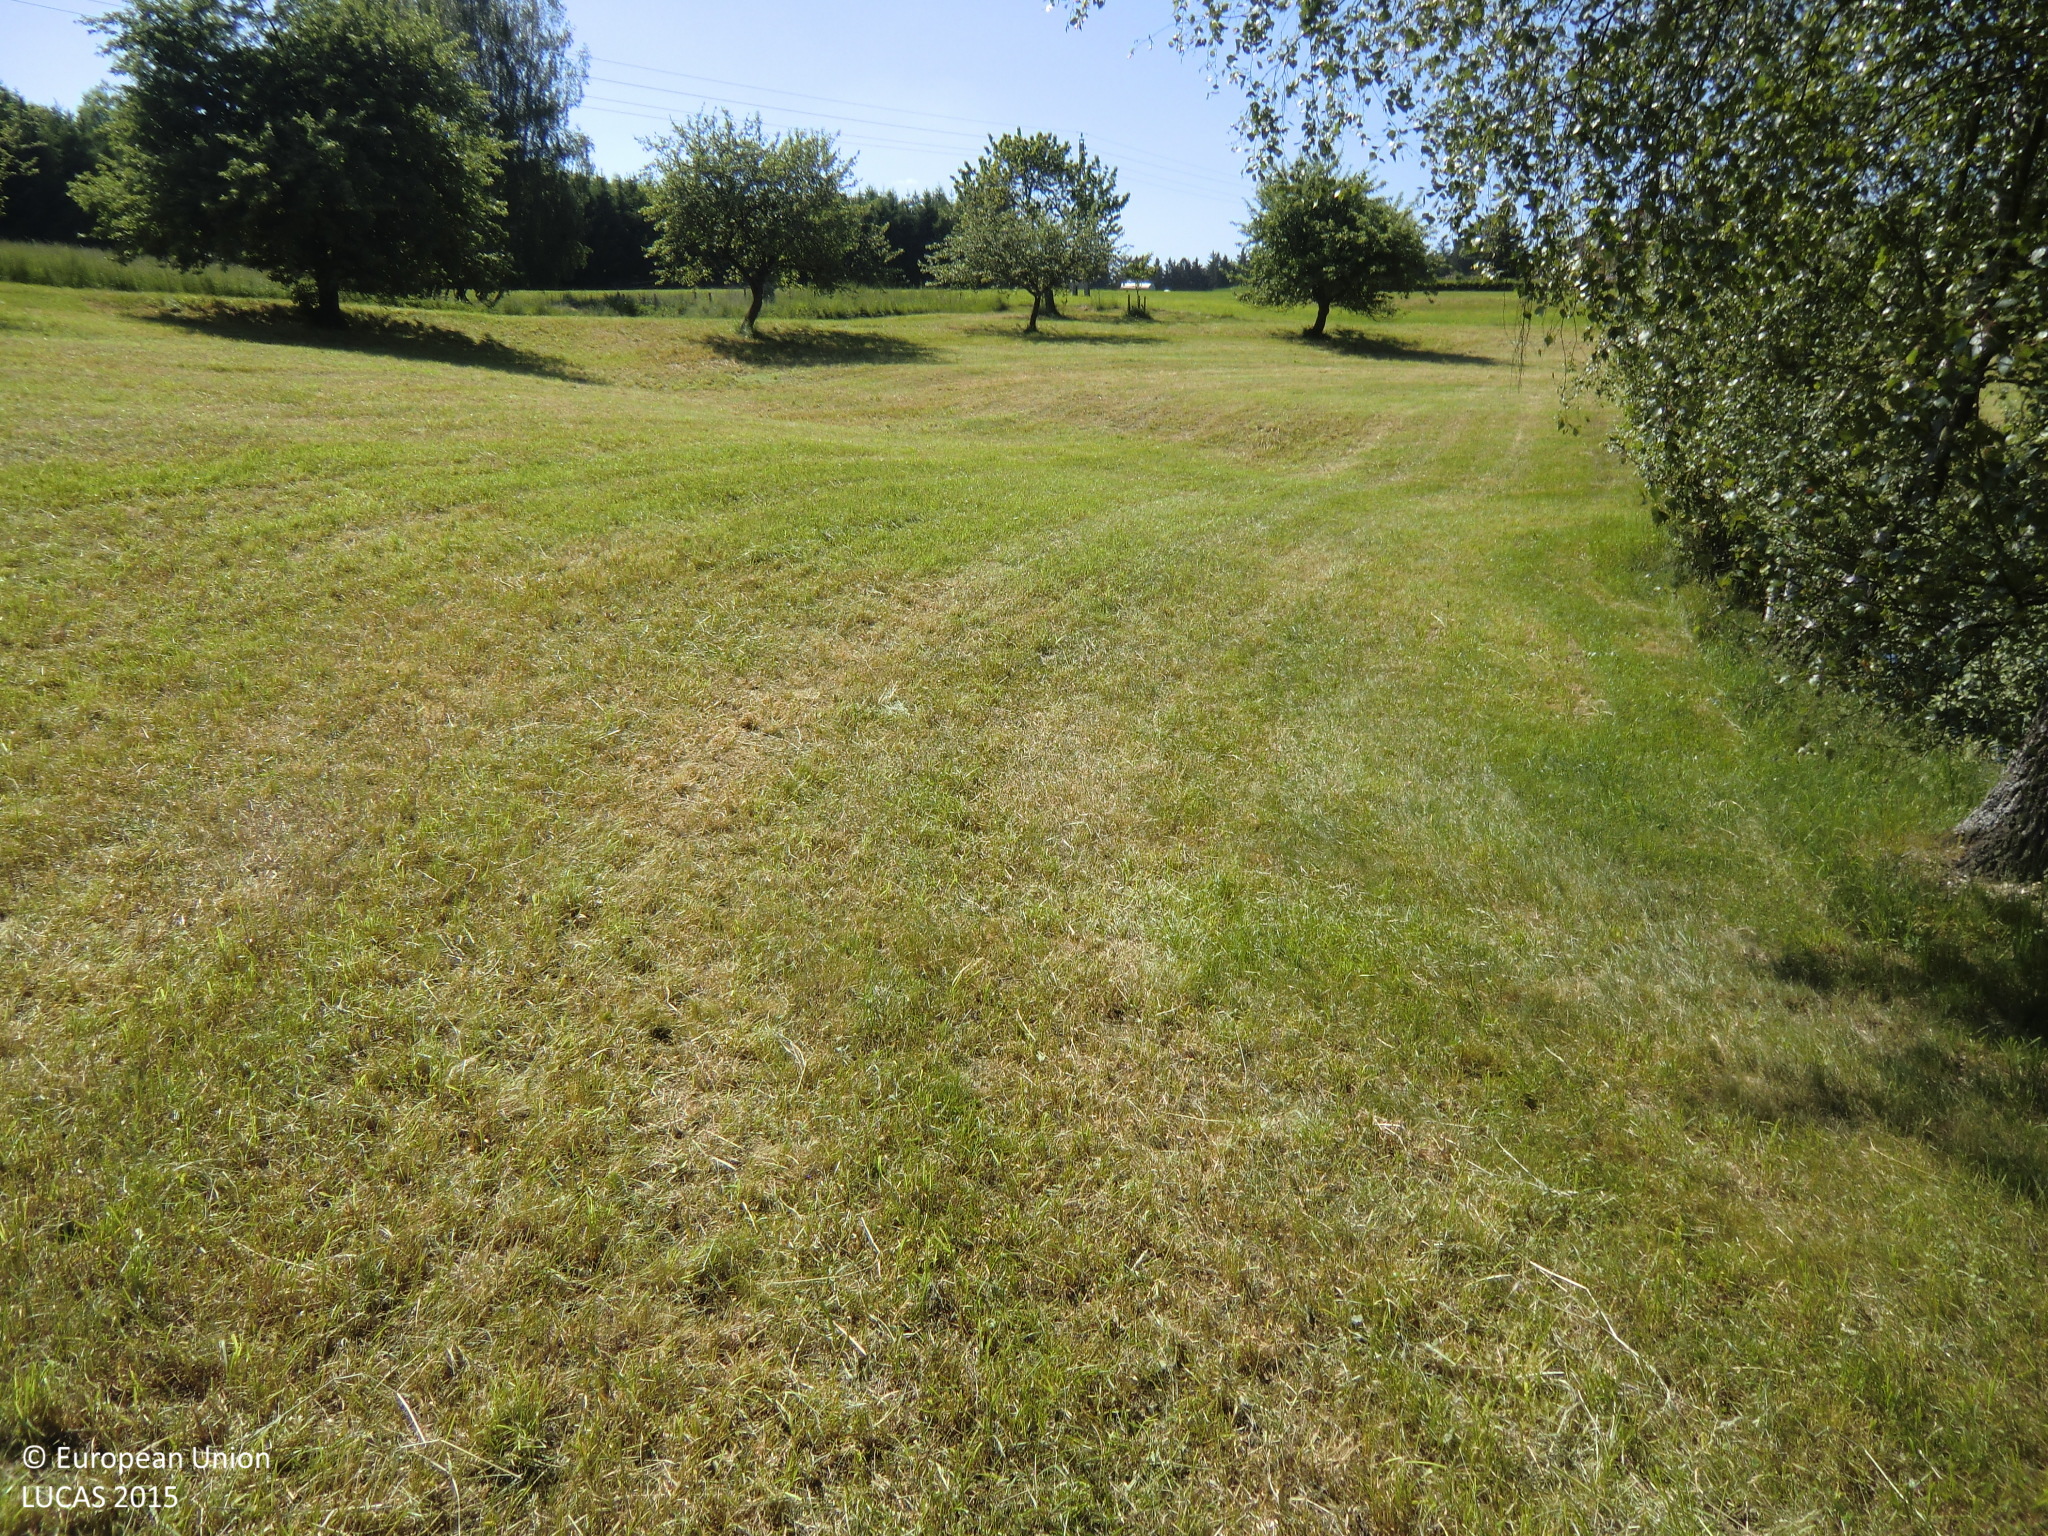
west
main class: Grassland
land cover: Grassland with sparse tree/shrub cover
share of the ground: > 75 %
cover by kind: herbaceous plants 95 %, broadleaved forest trees 5 %
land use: Agriculture (excluding fallow land and kitchen gardens)
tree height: > 5 m
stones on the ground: < 10 %
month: June
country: AT
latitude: 48.5321
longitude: 14.4018
